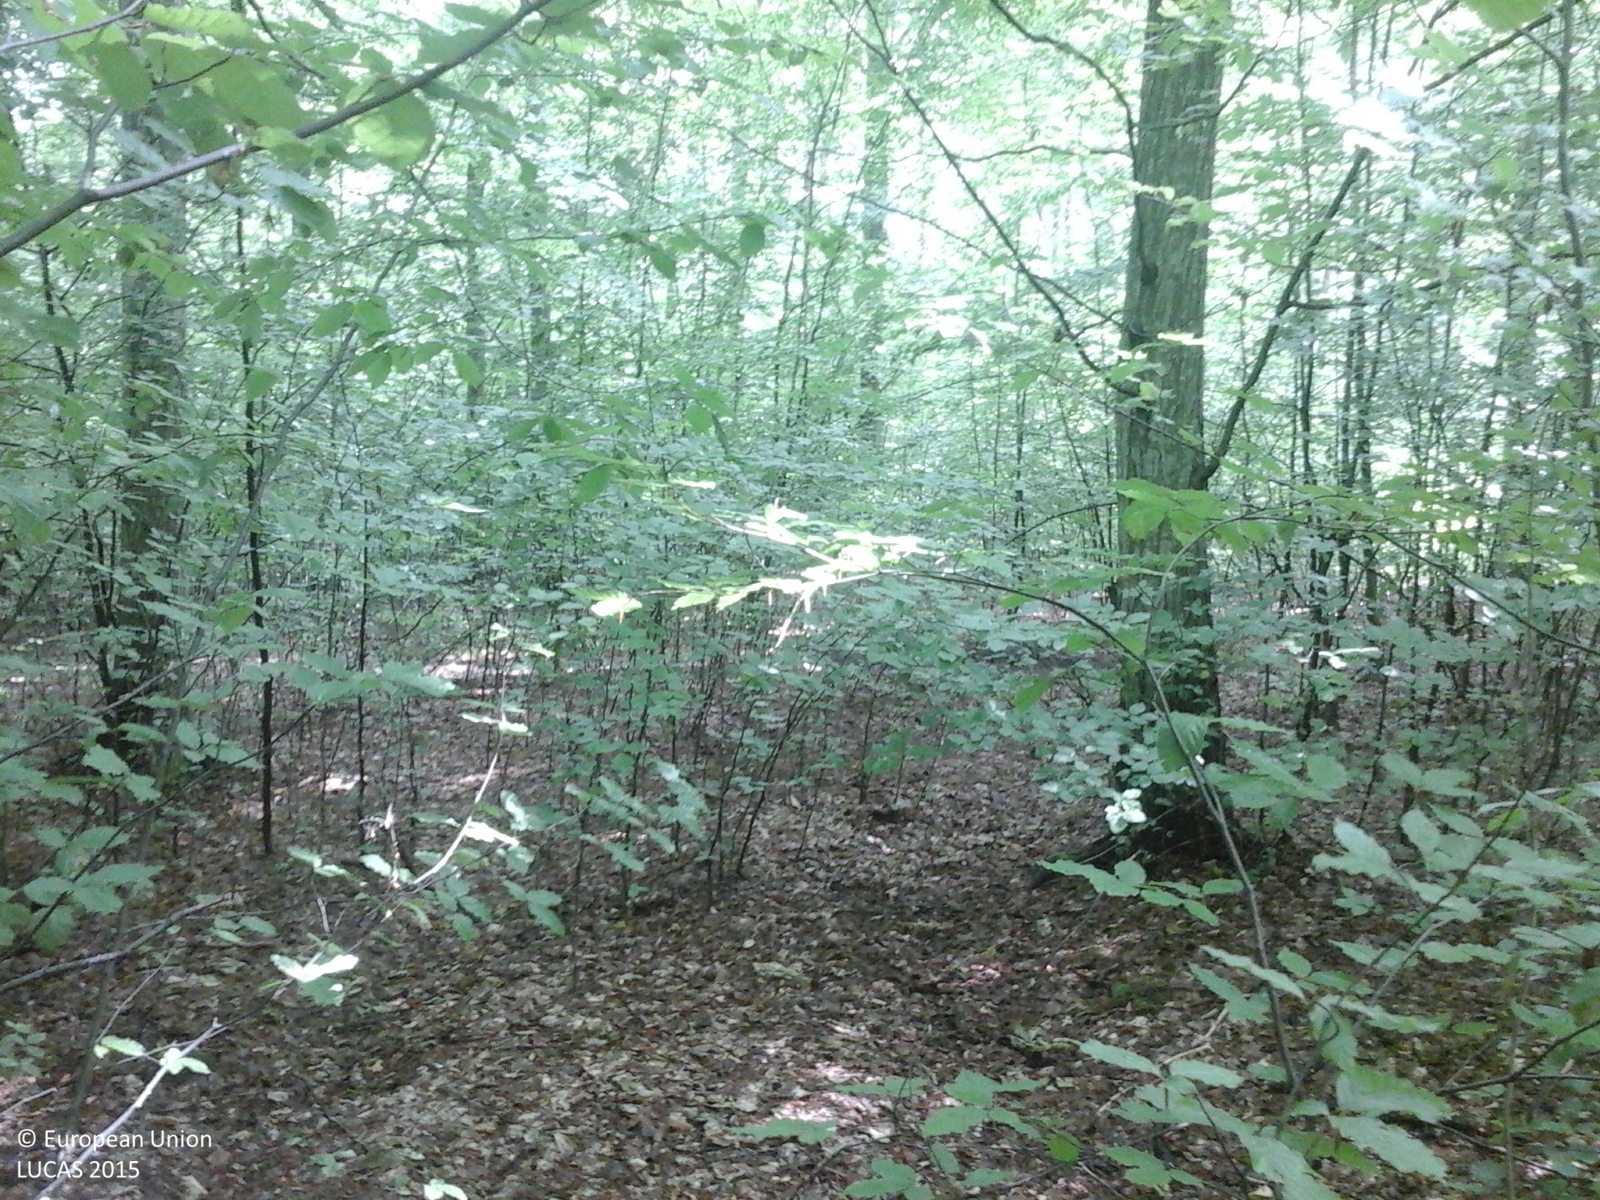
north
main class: Woodland
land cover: Broadleaved woodland
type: beech forest
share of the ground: 50 - 75 %
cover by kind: broadleaved forest trees 90 %, shrubs 10 %
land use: Forestry
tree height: > 5 m
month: June
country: RO
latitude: 47.2706
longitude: 26.3275
